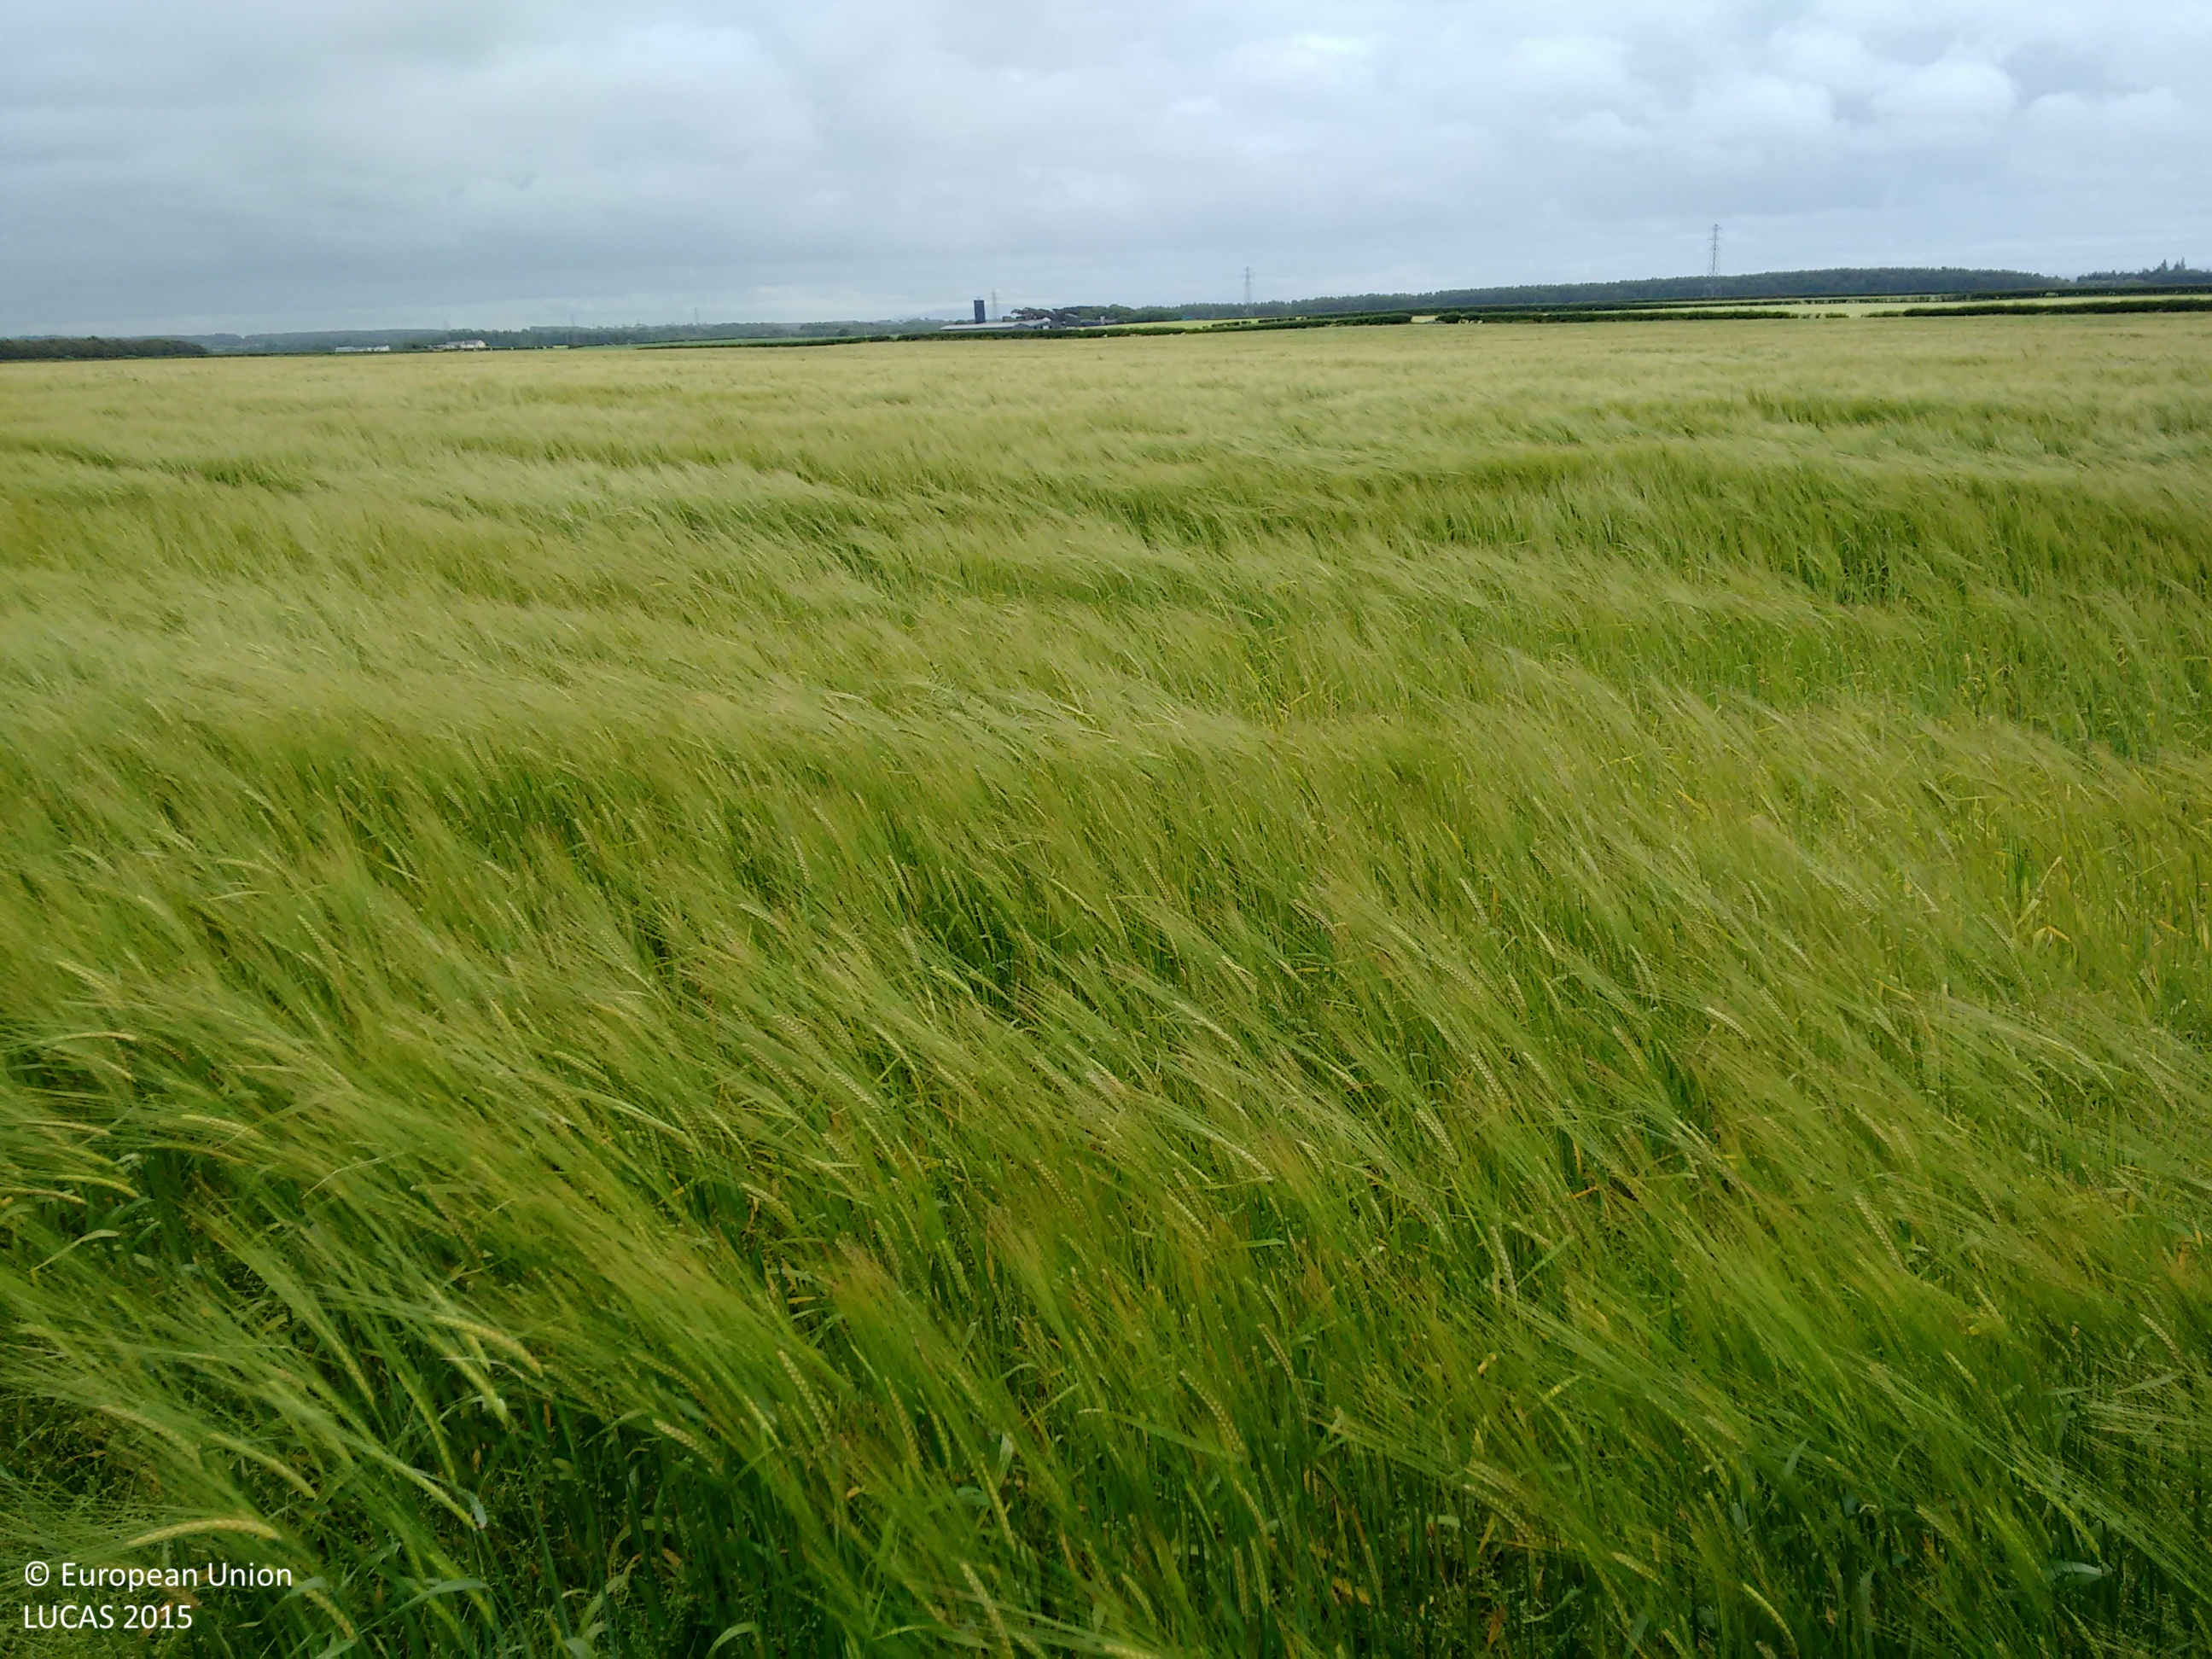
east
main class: Cropland
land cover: Barley
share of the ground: > 75 %
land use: Agriculture (excluding fallow land and kitchen gardens)
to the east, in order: Barley
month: July
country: GB
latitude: 54.9968
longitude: -3.3172
